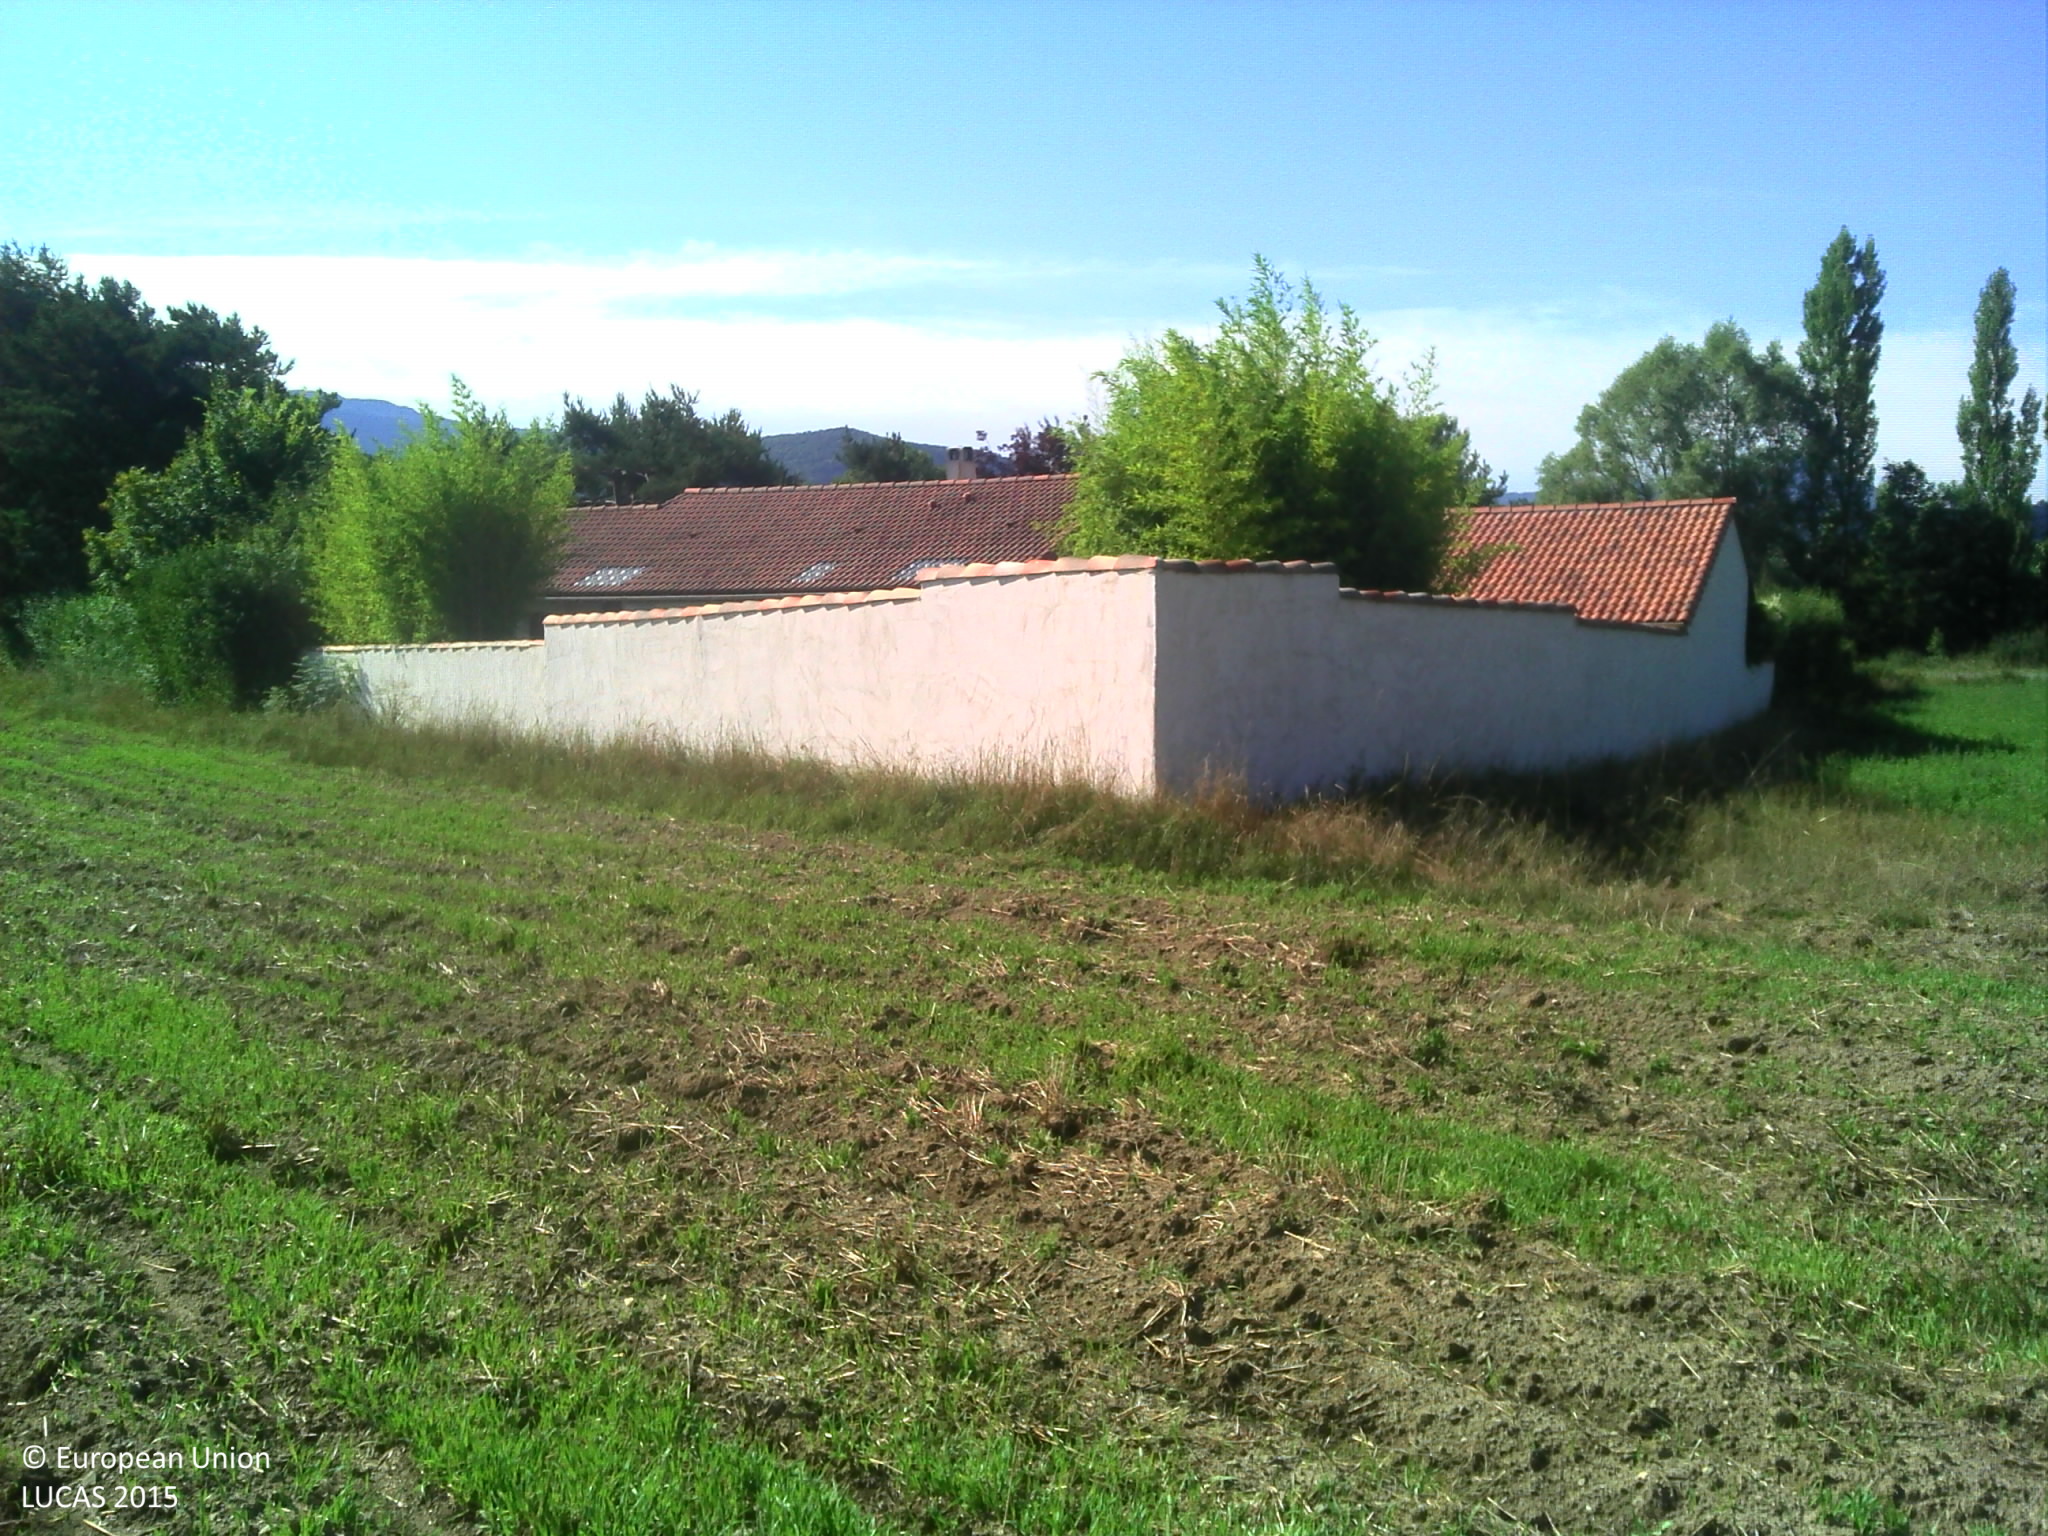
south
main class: Grassland
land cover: Grassland without tree/shrub cover
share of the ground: > 75 %
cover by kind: unconsolidated bare surface 60 %, herbaceous plants 40 %
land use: Agriculture (excluding fallow land and kitchen gardens)
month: August
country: FR
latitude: 44.1580
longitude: 6.2936
